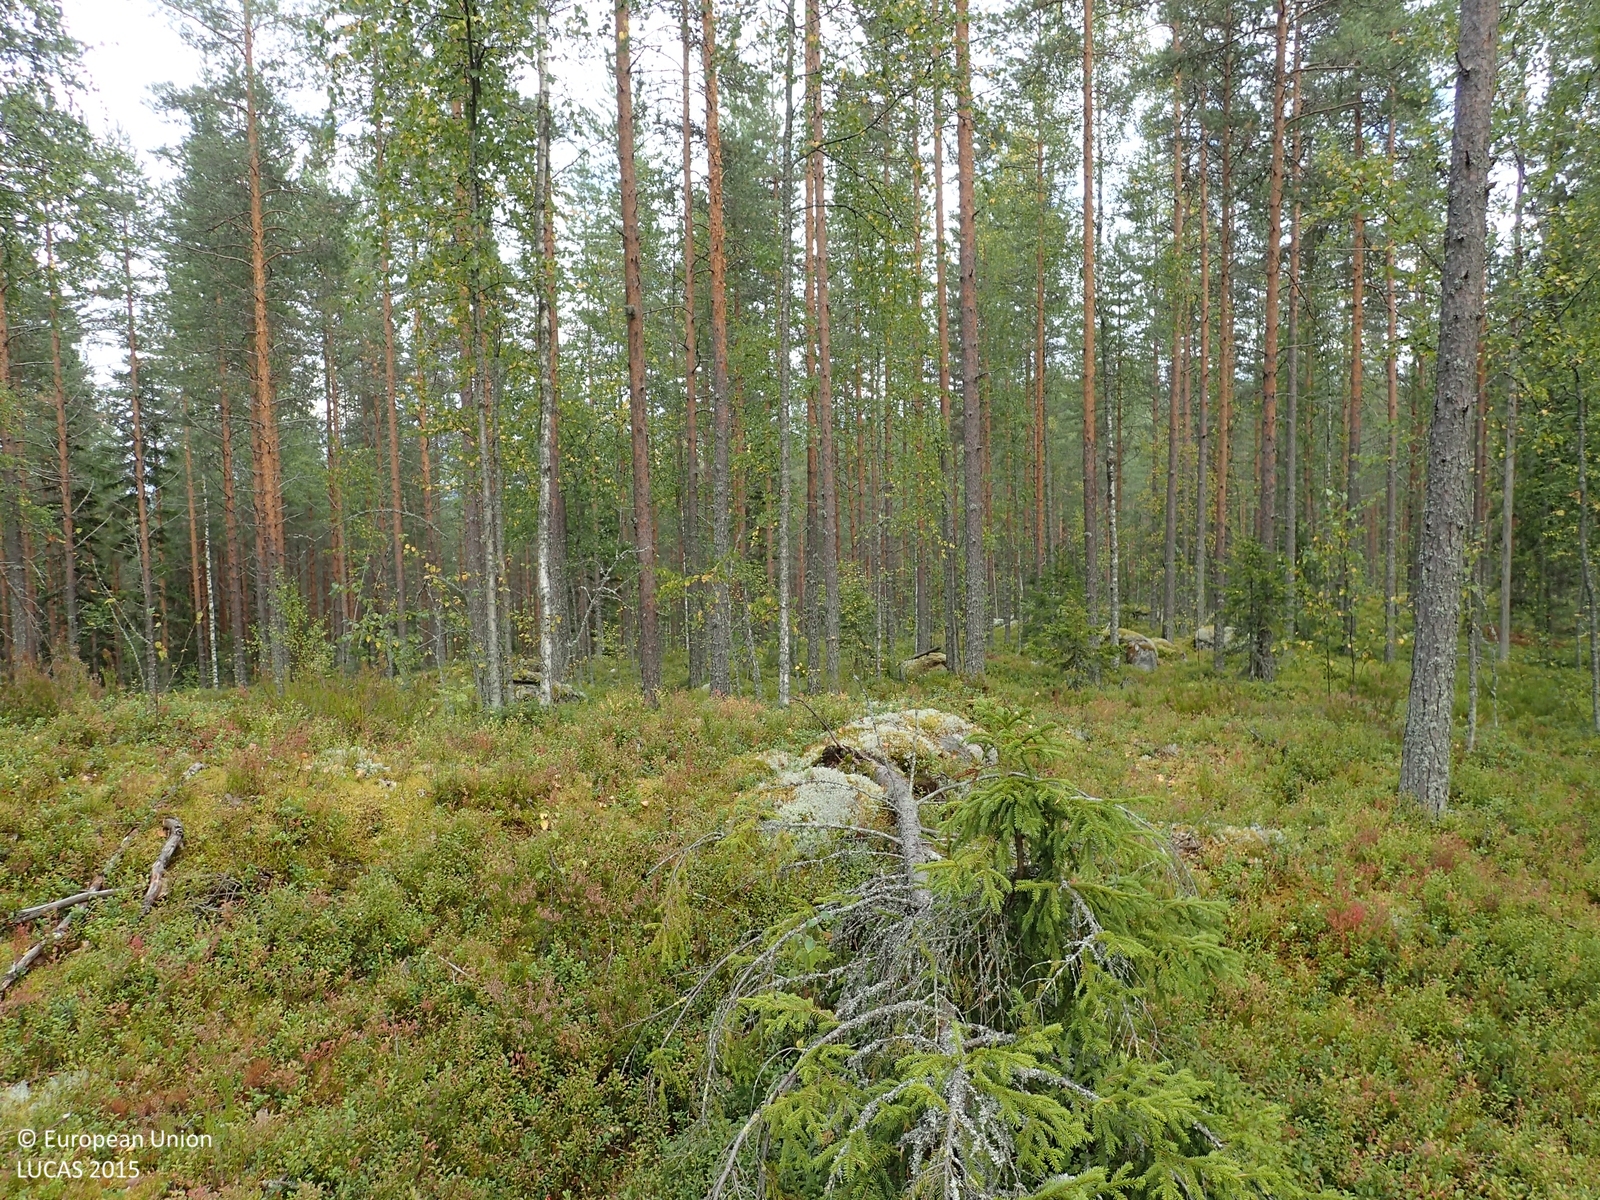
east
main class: Woodland
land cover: Pine dominated mixed woodland
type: boreal forest
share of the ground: 50 - 75 %
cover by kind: coniferous forest trees 45 %, shrubs 30 %, broadleaved forest trees 15 %, lichens and mosses 10 %
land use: Forestry
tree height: > 5 m
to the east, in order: Pine dominated mixed woodland; Ditches and canals; Paved roads, cycling and walking lanes; Ditches and canals; Pine dominated mixed woodland; Spruce dominated mixed woodland
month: September
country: FI
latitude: 63.1809
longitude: 25.9087
